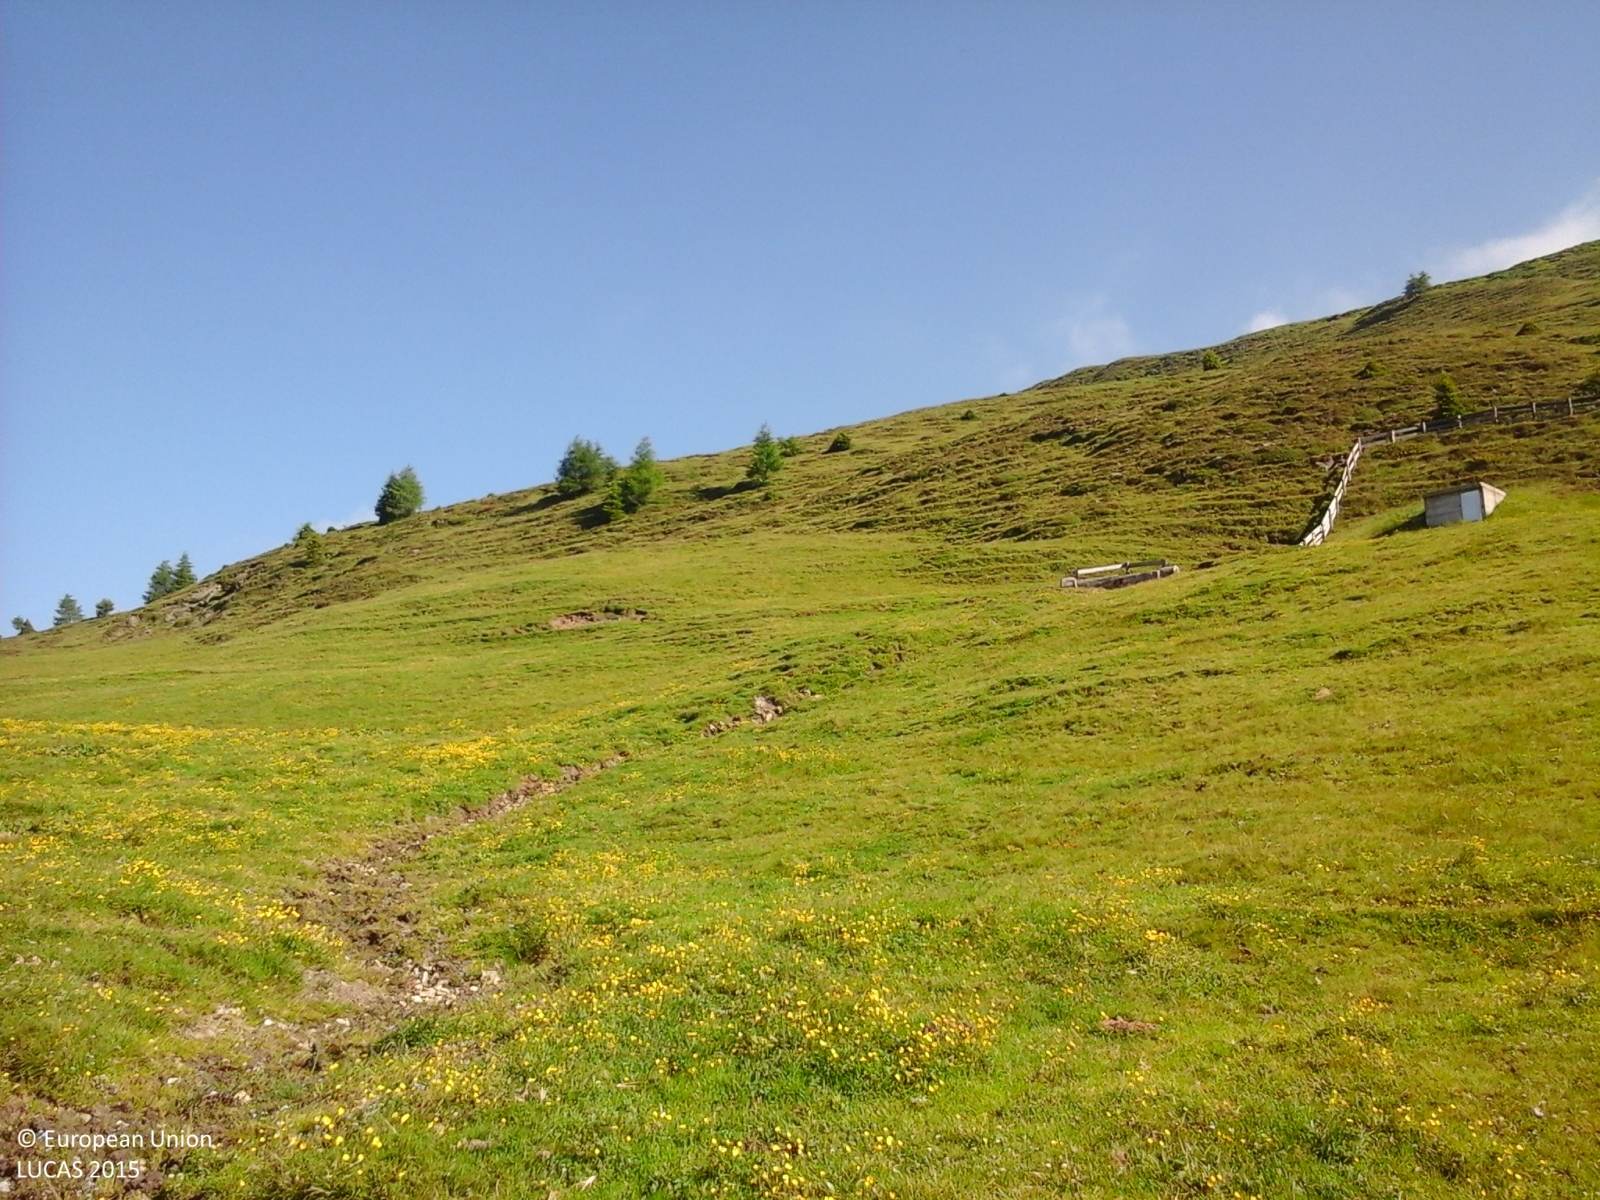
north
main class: Grassland
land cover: Grassland without tree/shrub cover
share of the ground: > 75 %
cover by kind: herbaceous plants 100 %
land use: Agriculture (excluding fallow land and kitchen gardens)
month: July
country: IT
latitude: 46.6843
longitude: 12.4163
